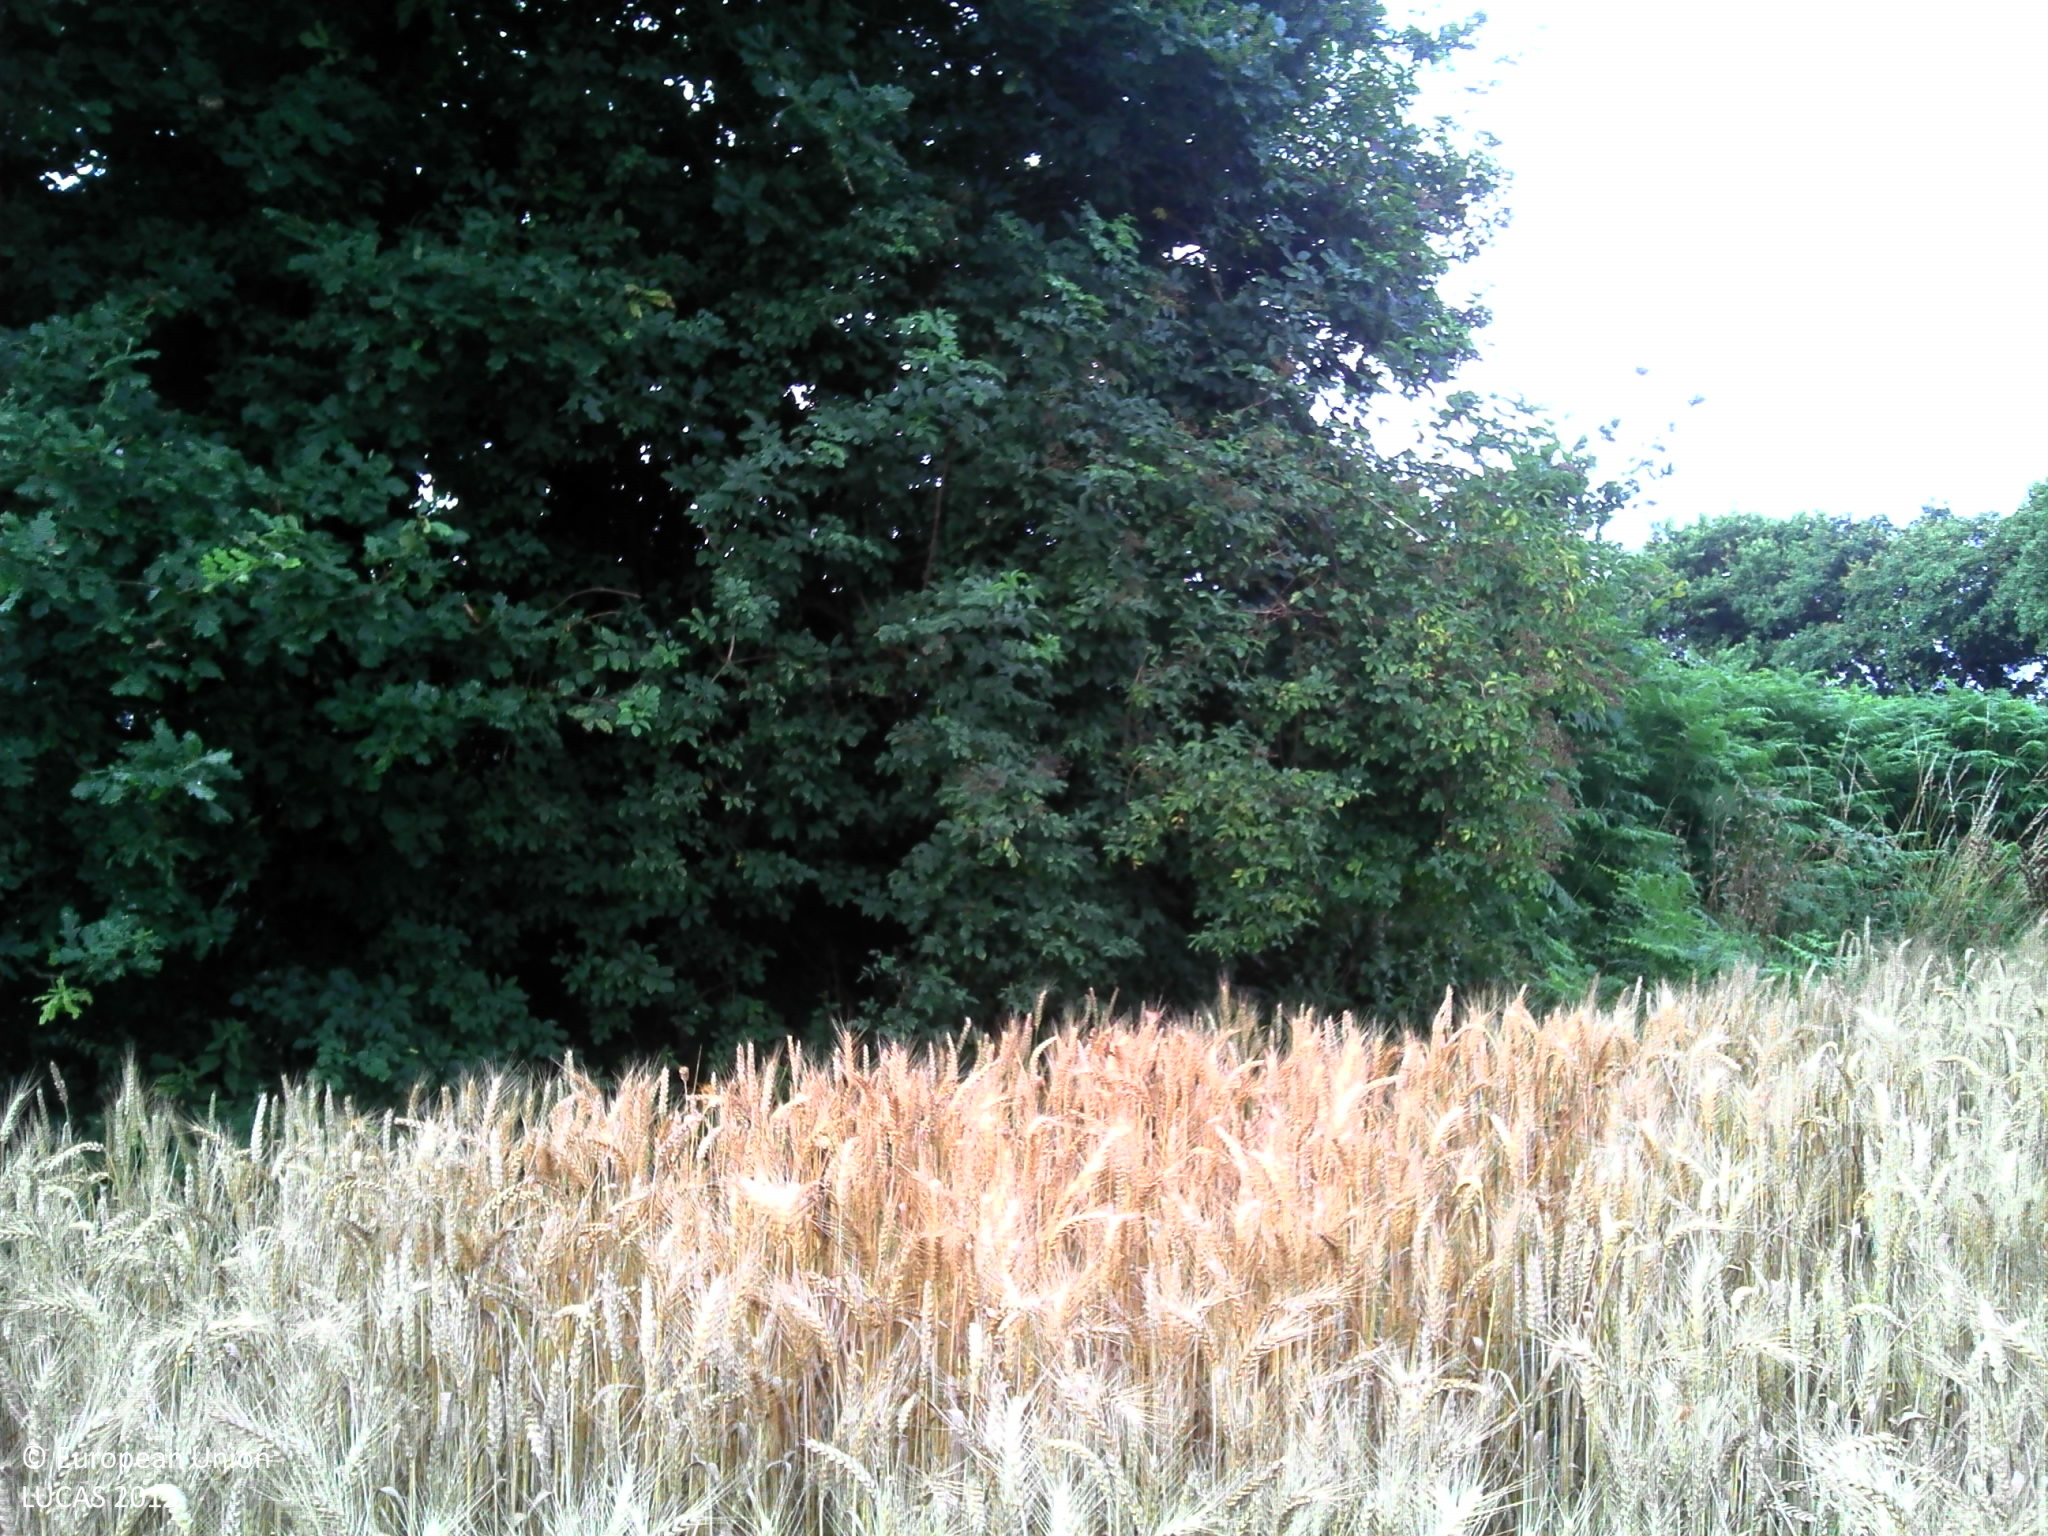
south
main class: Cropland
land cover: Common wheat
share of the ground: > 75 %
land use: Agriculture (excluding fallow land and kitchen gardens)
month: August
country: FR
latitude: 48.2681
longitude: -3.3180
